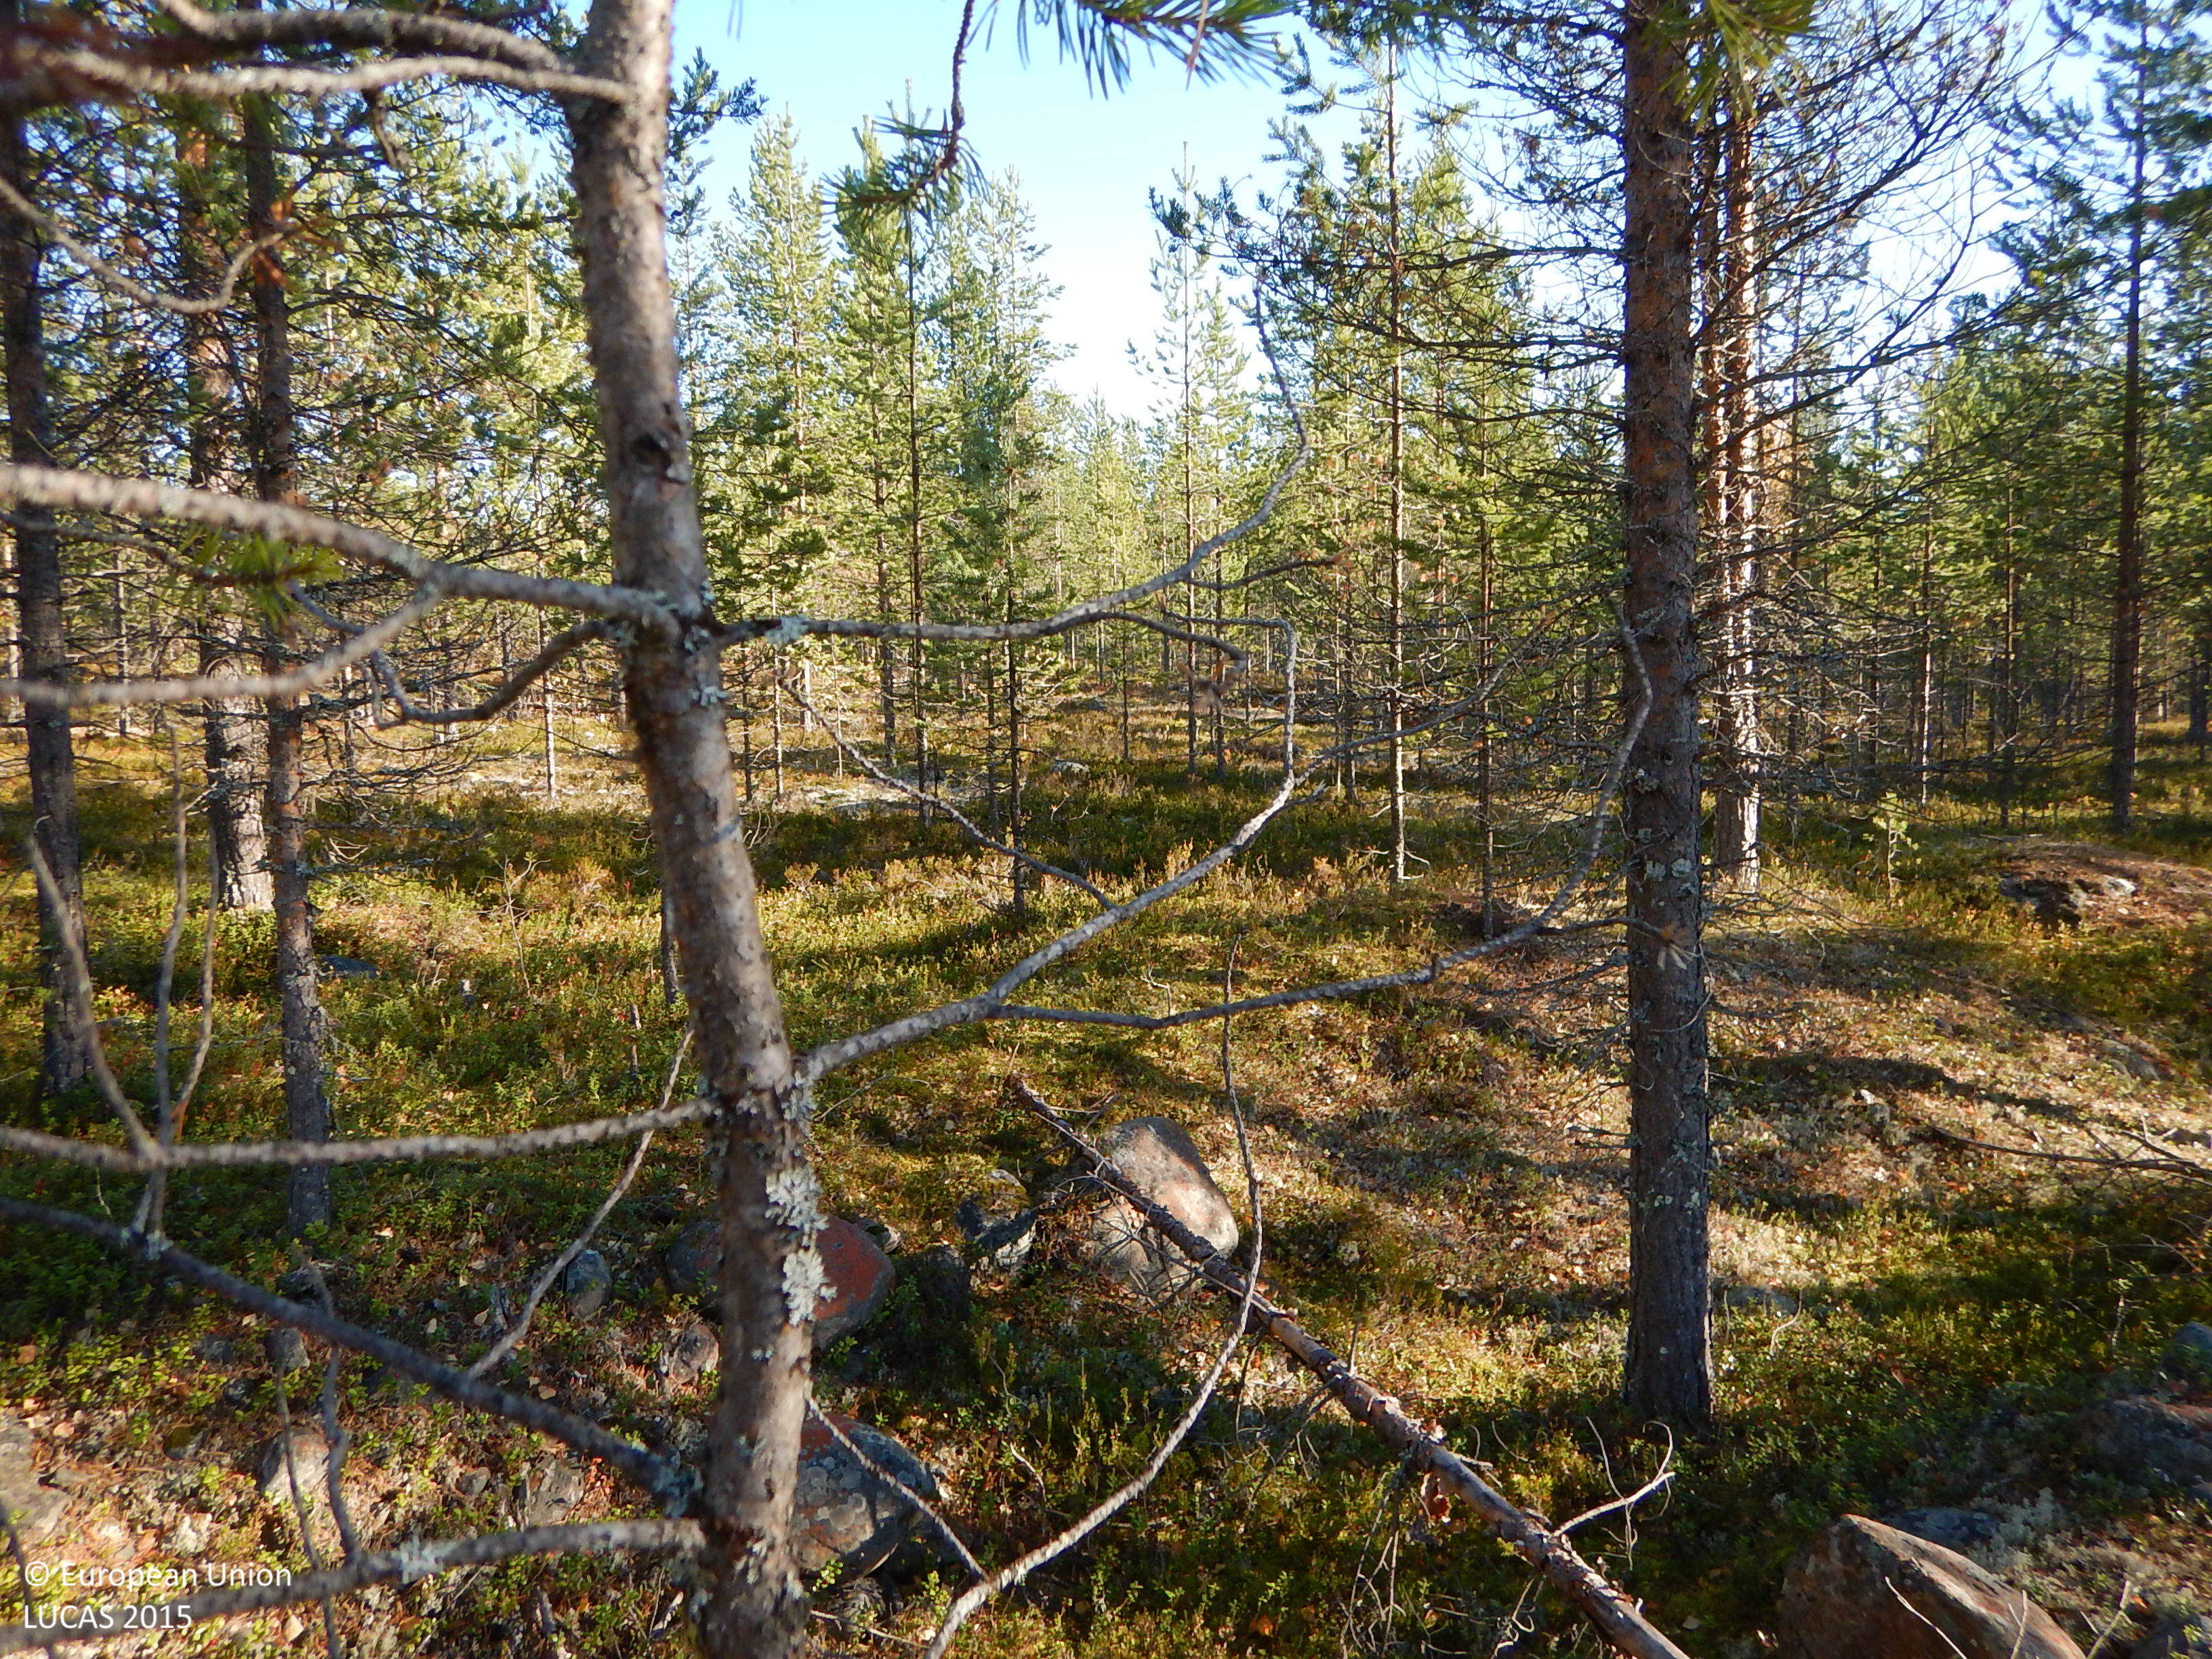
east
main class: Woodland
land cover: Pine dominated coniferous woodland
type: boreal forest
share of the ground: 50 - 75 %
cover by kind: coniferous forest trees 60 %, shrubs 20 %, lichens and mosses 20 %
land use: Forestry
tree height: > 5 m
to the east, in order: Pine dominated coniferous woodland
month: October
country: SE
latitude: 65.0861
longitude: 21.1025
